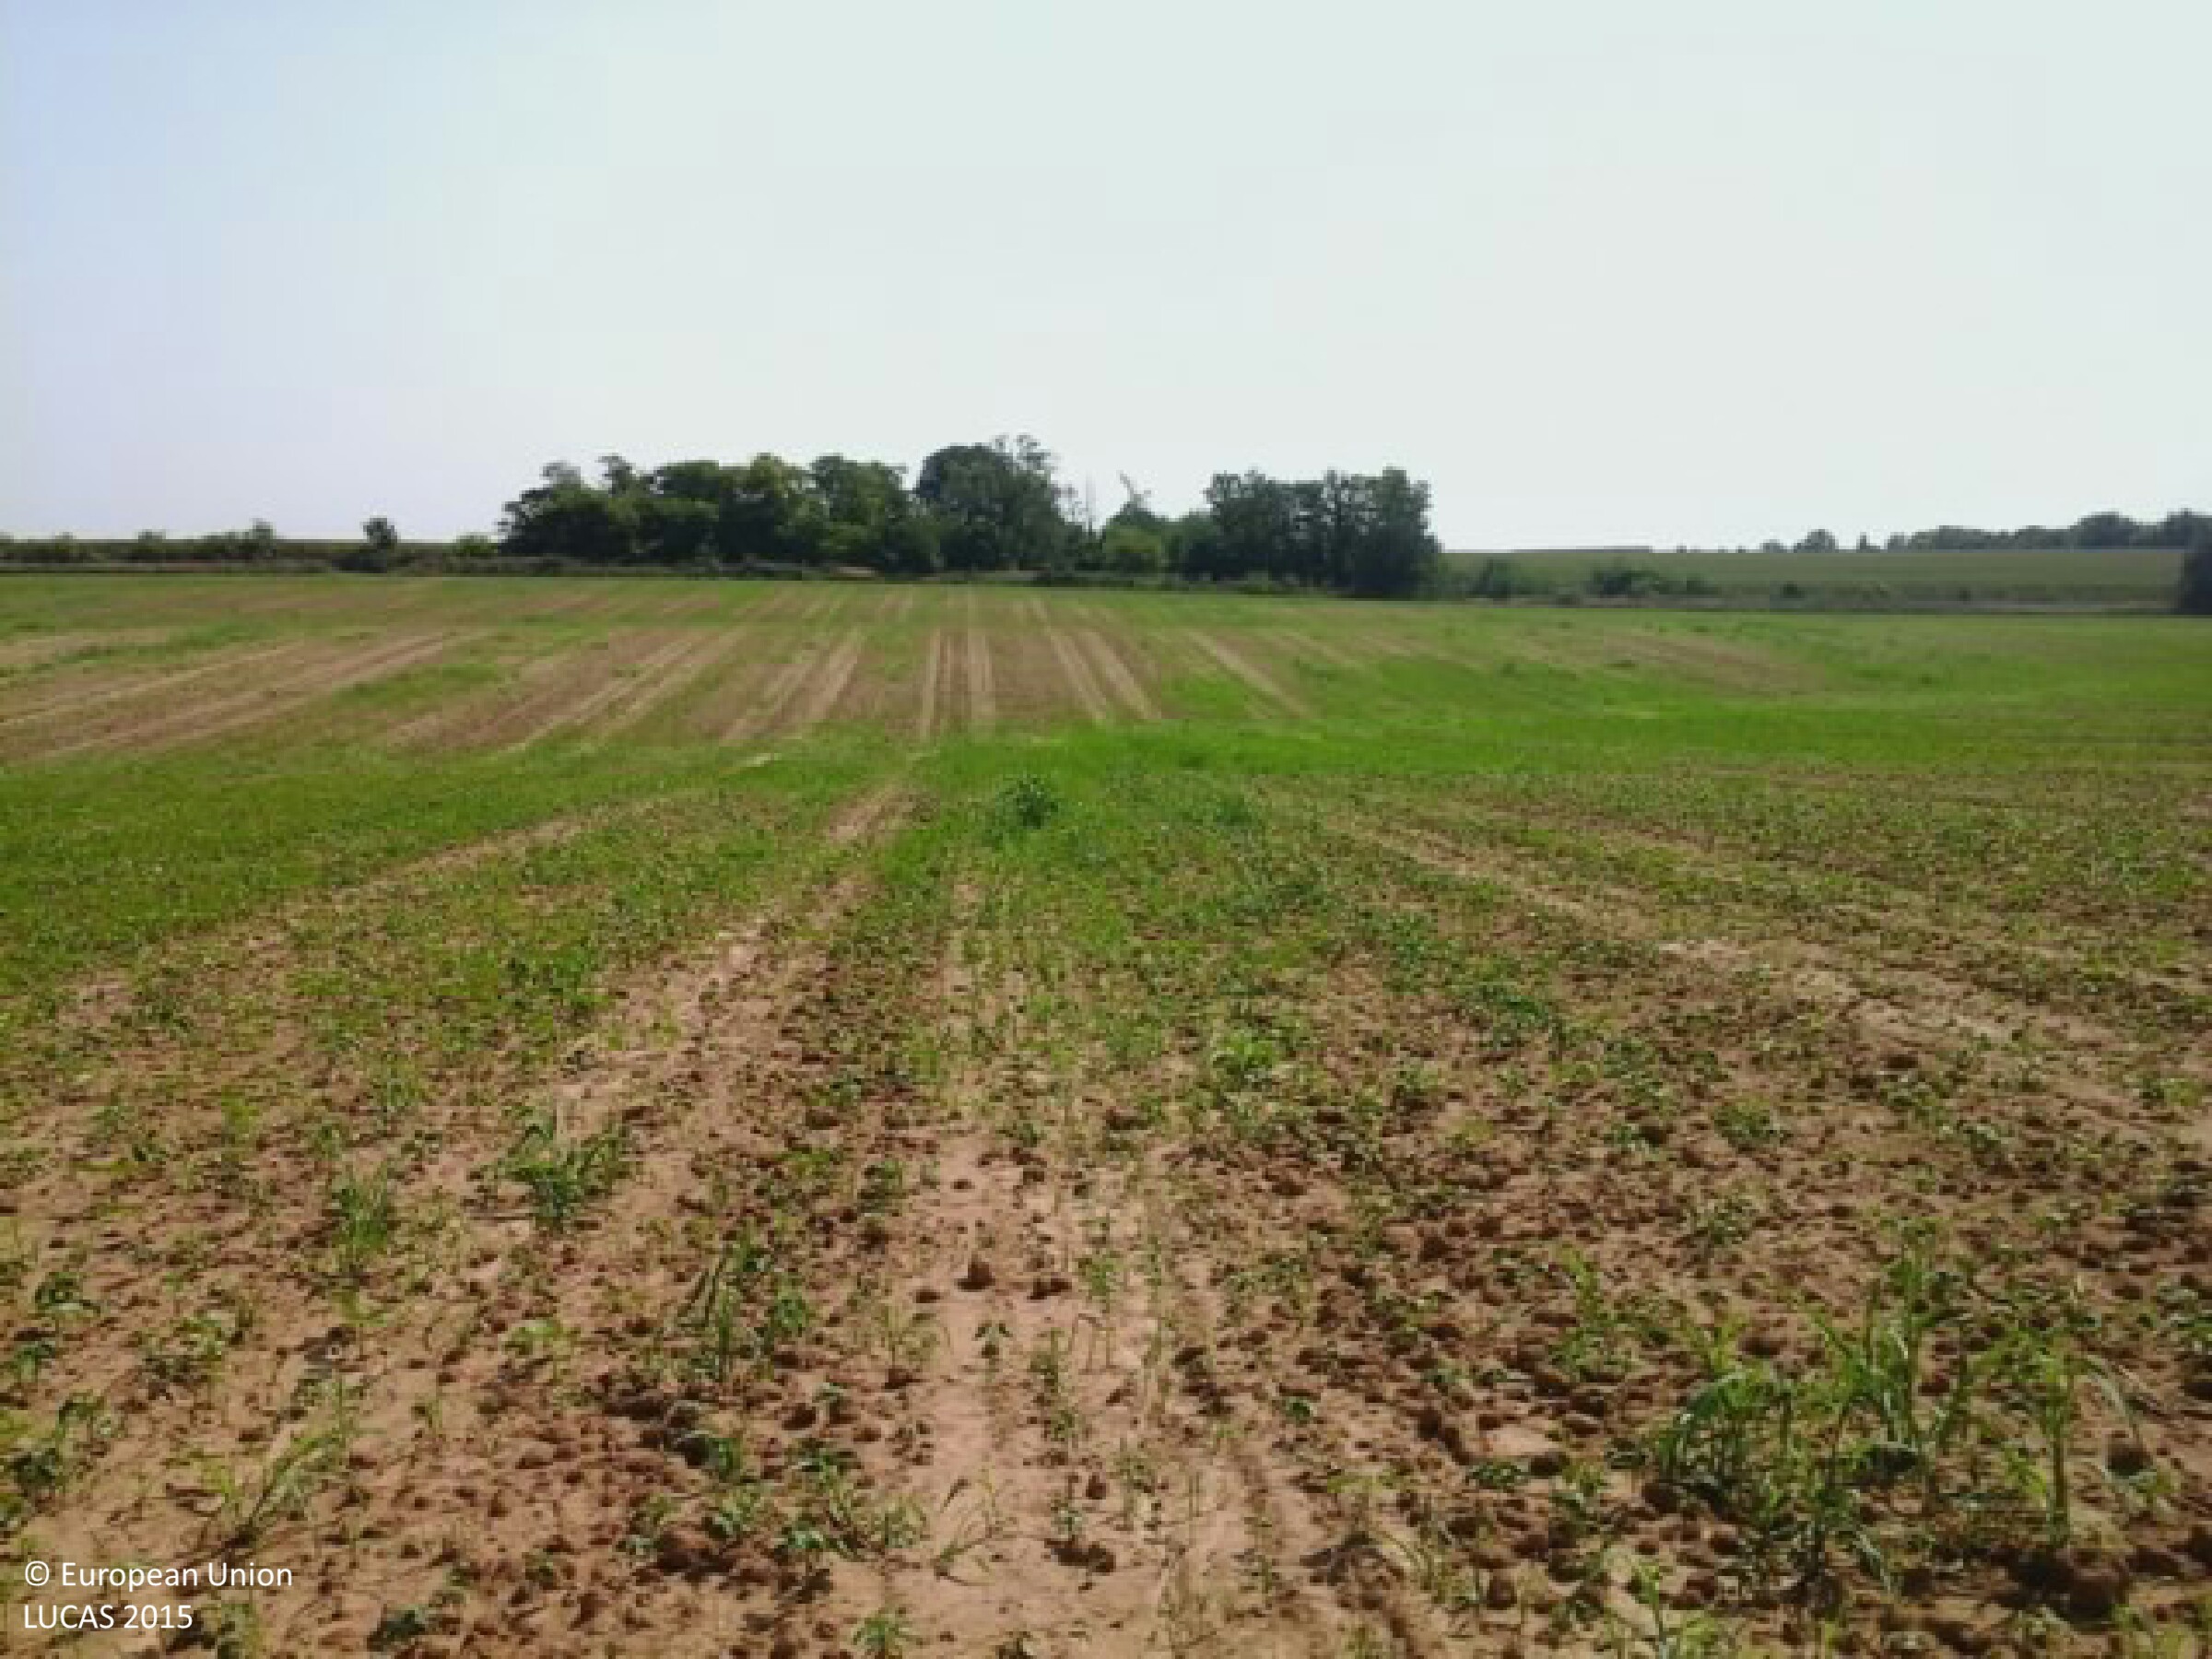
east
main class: Cropland
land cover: Other cereals
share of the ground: 50 - 75 %
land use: Agriculture (excluding fallow land and kitchen gardens)
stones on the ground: < 10 %
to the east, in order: Other cereals; Shrubland without tree cover; Tracks; Shrubland with sparse tree cover
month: August
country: HU
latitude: 46.5314
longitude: 17.8686
